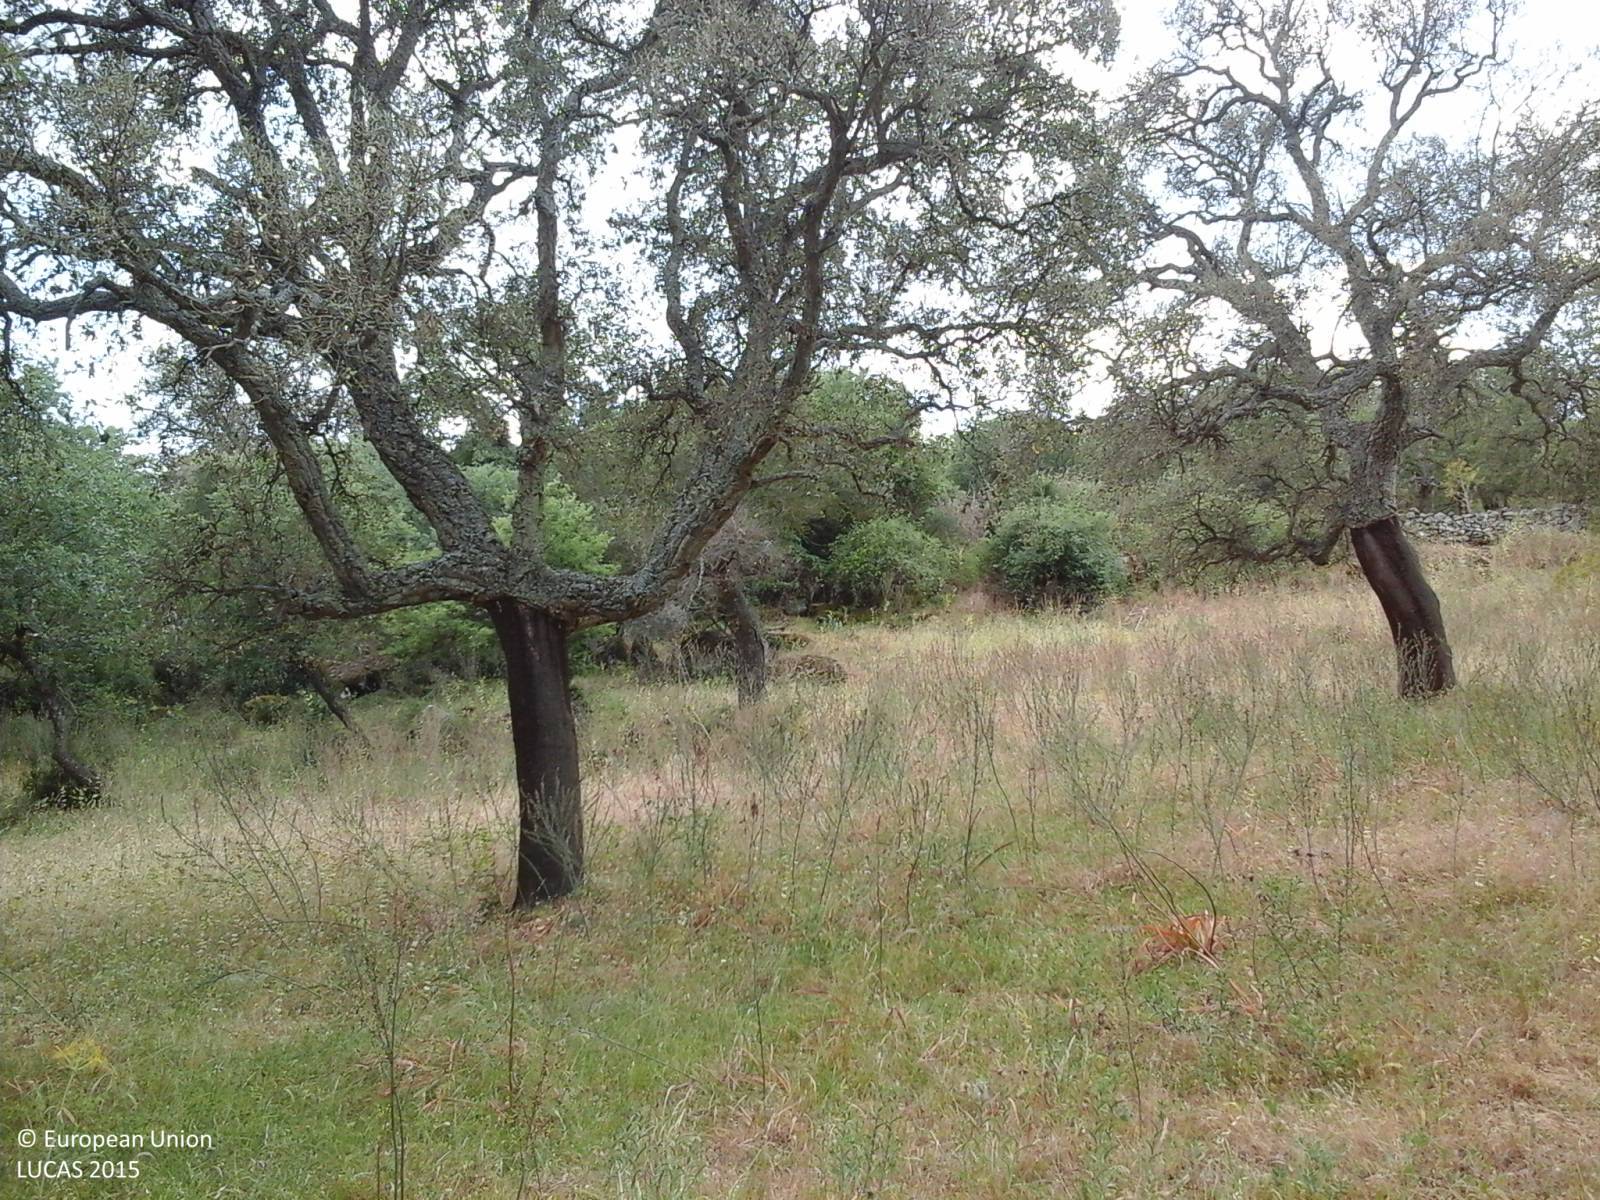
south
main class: Woodland
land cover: Broadleaved woodland
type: broadleaved evergreen forest
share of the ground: > 75 %
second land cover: Grassland without tree/shrub cover
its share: > 75 %
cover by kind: broadleaved forest trees 80 %, herbaceous plants 20 %
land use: Forestry
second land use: Agriculture (excluding fallow land and kitchen gardens)
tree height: > 5 m
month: June
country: IT
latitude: 40.4991
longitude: 9.1664
